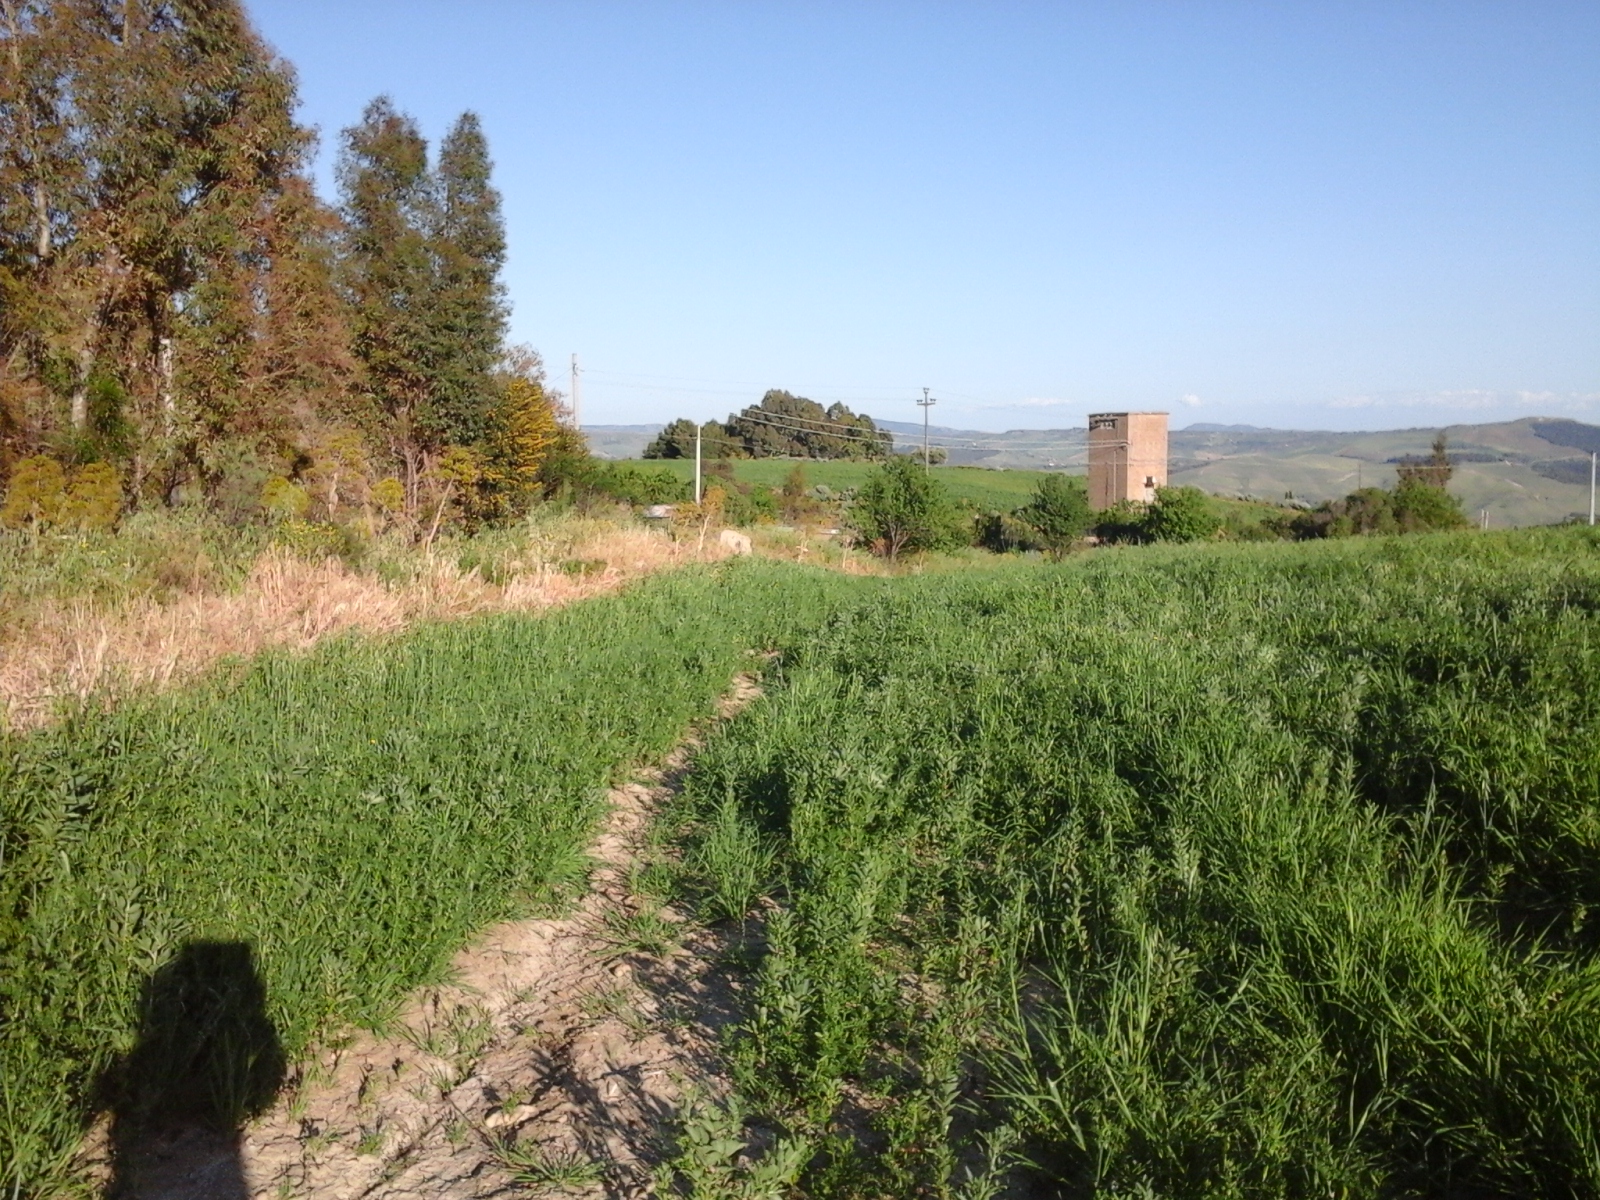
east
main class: Cropland
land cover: Dry pulses
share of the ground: > 75 %
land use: Agriculture (excluding fallow land and kitchen gardens)
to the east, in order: Dry pulses; Grass margins; Ditches and canals; Shrubland without tree cover; Grass margins; Paved roads, cycling and walking lanes; Electric lines; Paved roads, cycling and walking lanes; Fences; Shrubland with sparse tree cover; Electric lines; Shrubland with sparse tree cover; Inland fresh water bodies; Rocks and stones; Shrubland with sparse tree cover
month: May
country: IT
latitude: 37.4947
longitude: 14.1203
